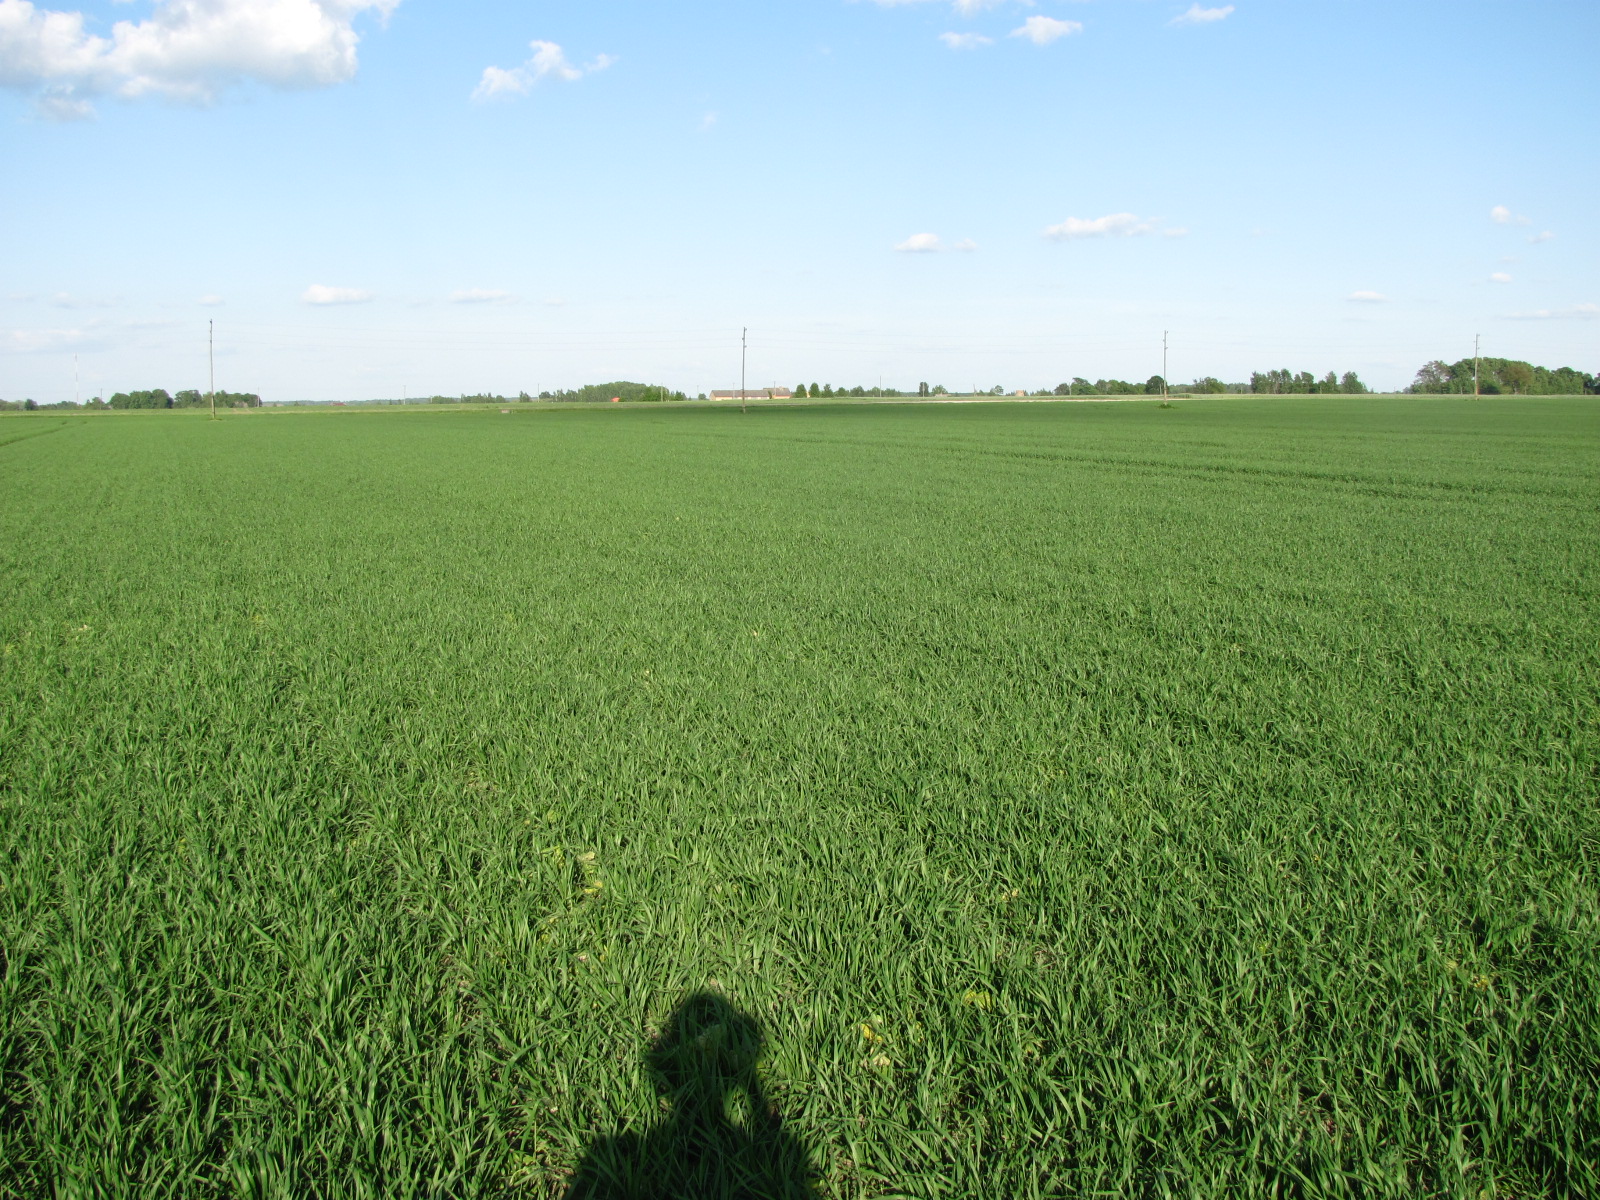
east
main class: Cropland
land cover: Common wheat
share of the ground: > 75 %
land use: Agriculture (excluding fallow land and kitchen gardens)
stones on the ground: < 10 %
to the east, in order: Common wheat; Electric lines; Common wheat; Spontaneously vegetated surfaces; Paved roads, cycling and walking lanes; Spontaneously vegetated surfaces; Dry pulses
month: May
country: LV
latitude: 56.5529
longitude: 23.9607
